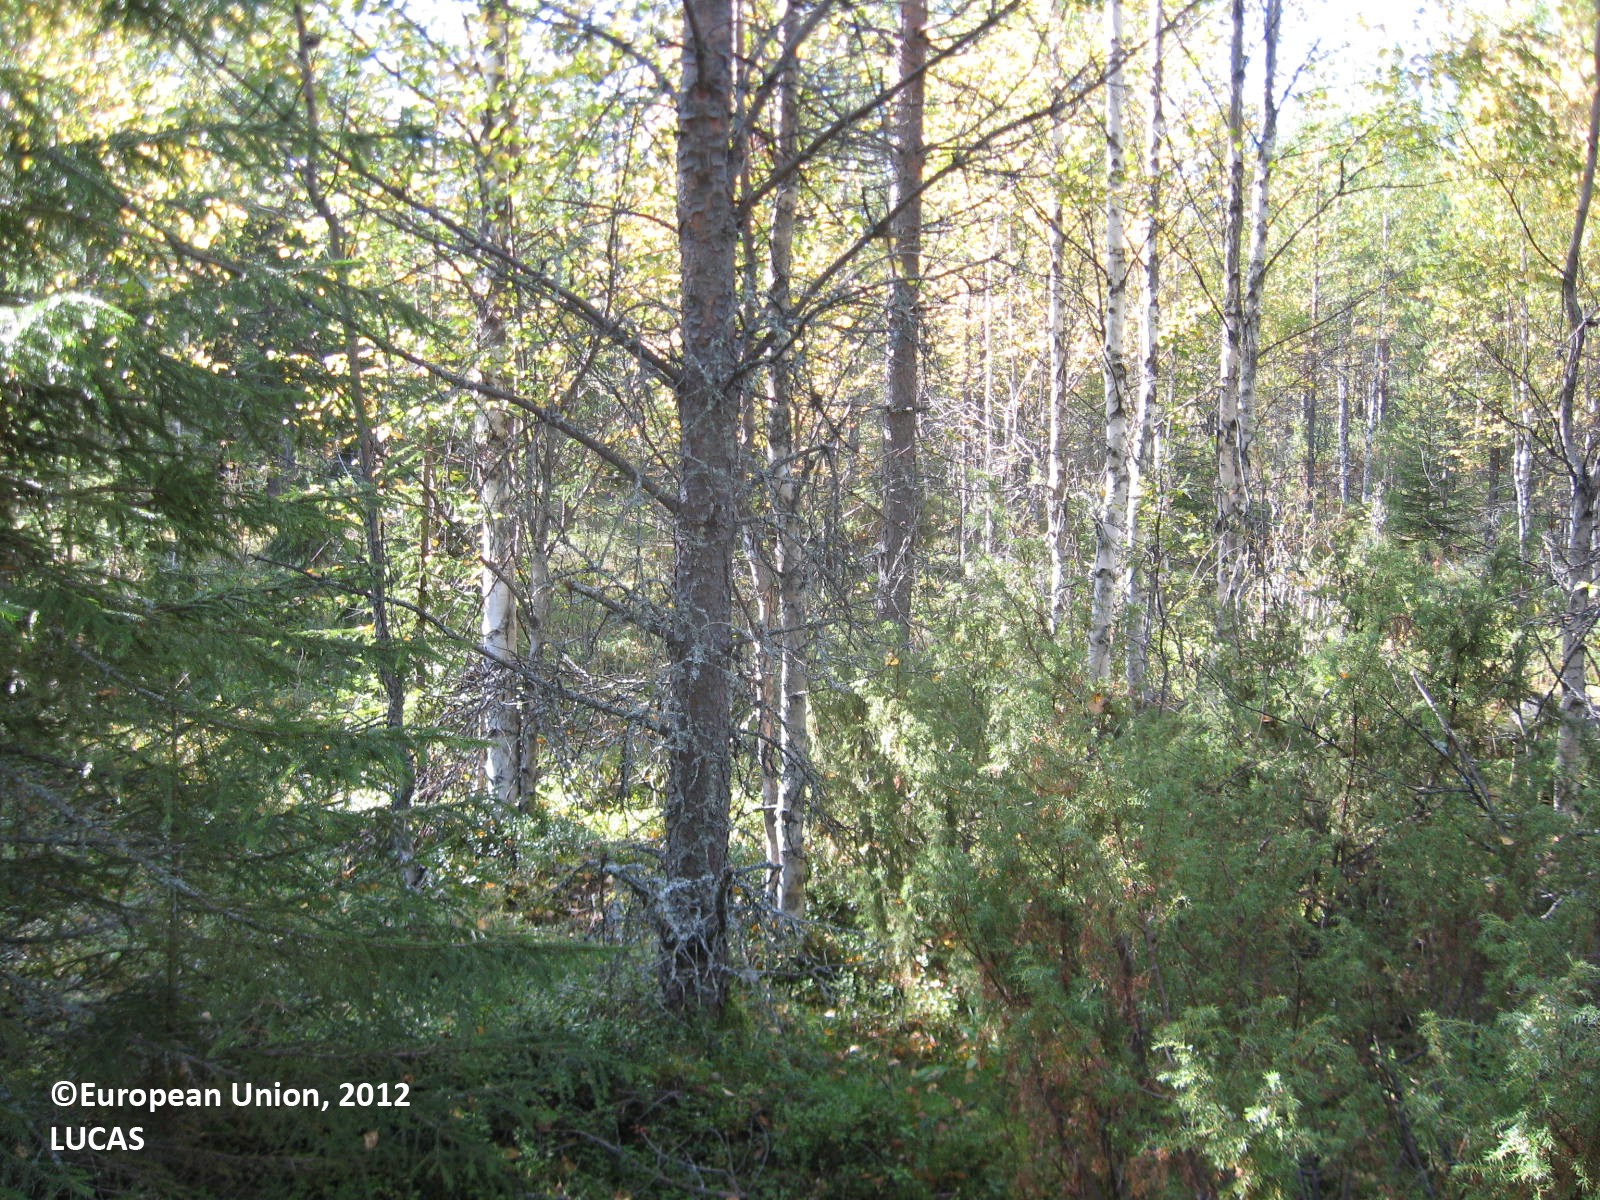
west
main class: Woodland
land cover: Other mixed woodland
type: boreal forest
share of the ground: > 75 %
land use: Forestry
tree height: > 5 m
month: August
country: FI
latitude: 63.8858
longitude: 28.7014
